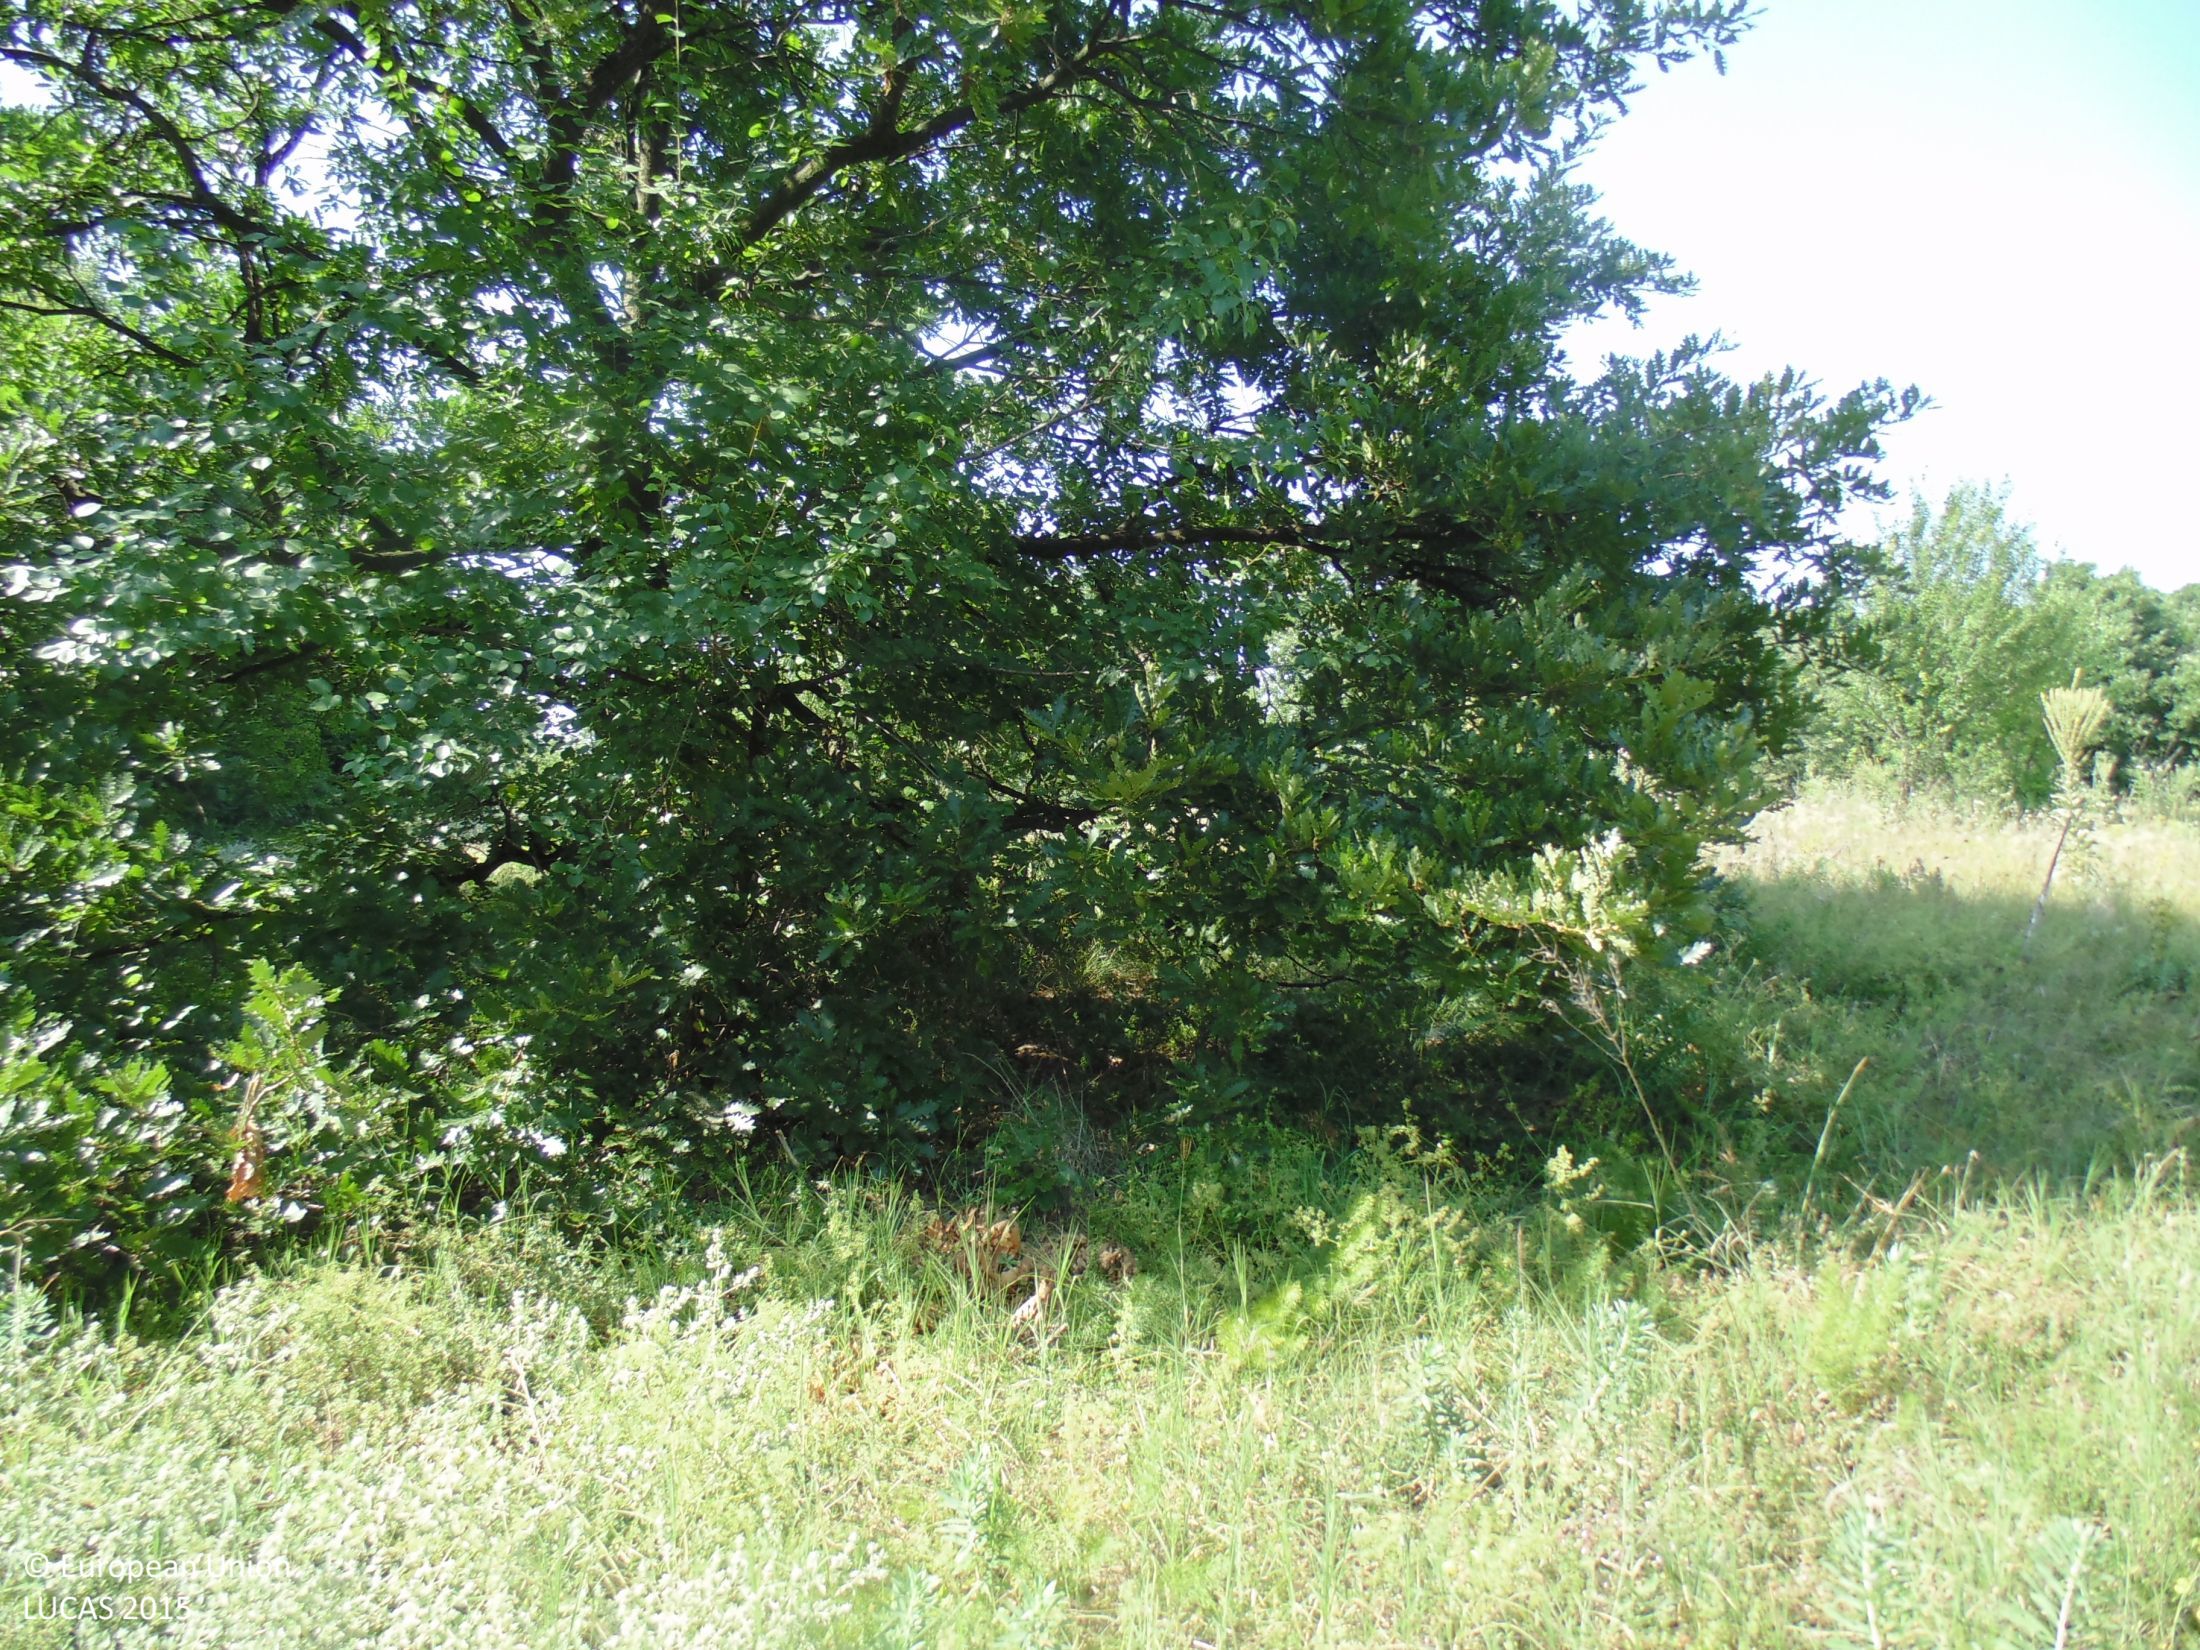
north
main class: Woodland
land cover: Broadleaved woodland
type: mesophytic deciduous forest
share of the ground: > 75 %
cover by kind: broadleaved forest trees 75 %, herbaceous plants 20 %, shrubs 5 %
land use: Forestry
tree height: > 5 m
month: July
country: BG
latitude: 43.5980
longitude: 27.5378
